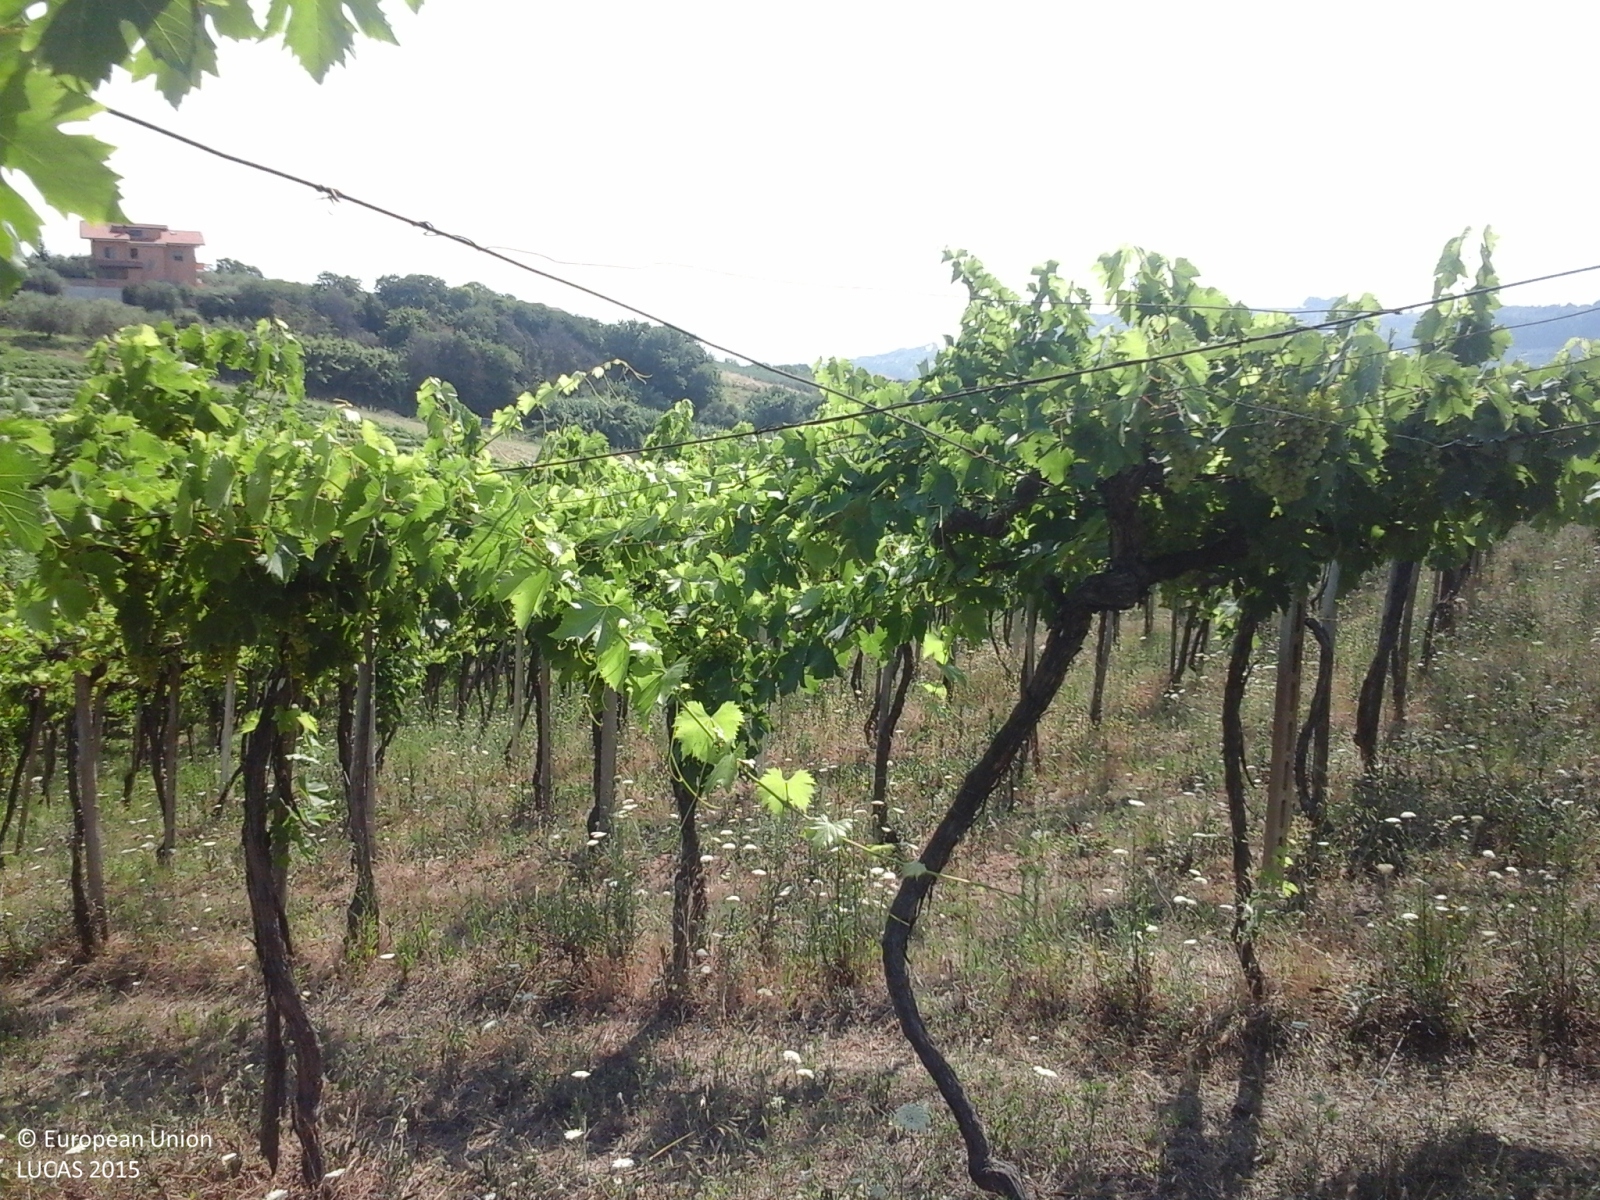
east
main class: Cropland
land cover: Vineyards
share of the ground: 50 - 75 %
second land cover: Spontaneously vegetated surfaces
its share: > 75 %
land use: Agriculture (excluding fallow land and kitchen gardens)
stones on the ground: 10 - 25 %
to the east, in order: Vineyards; Spontaneously vegetated surfaces; Abandoned hedges; Ditches and canals; Abandoned hedges; Maize; Spontaneously vegetated surfaces; Abandoned hedges; Paved roads, cycling and walking lanes; Grass margins; Olive groves; Grassland without tree/shrub cover
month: July
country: IT
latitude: 42.4200
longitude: 14.2531
